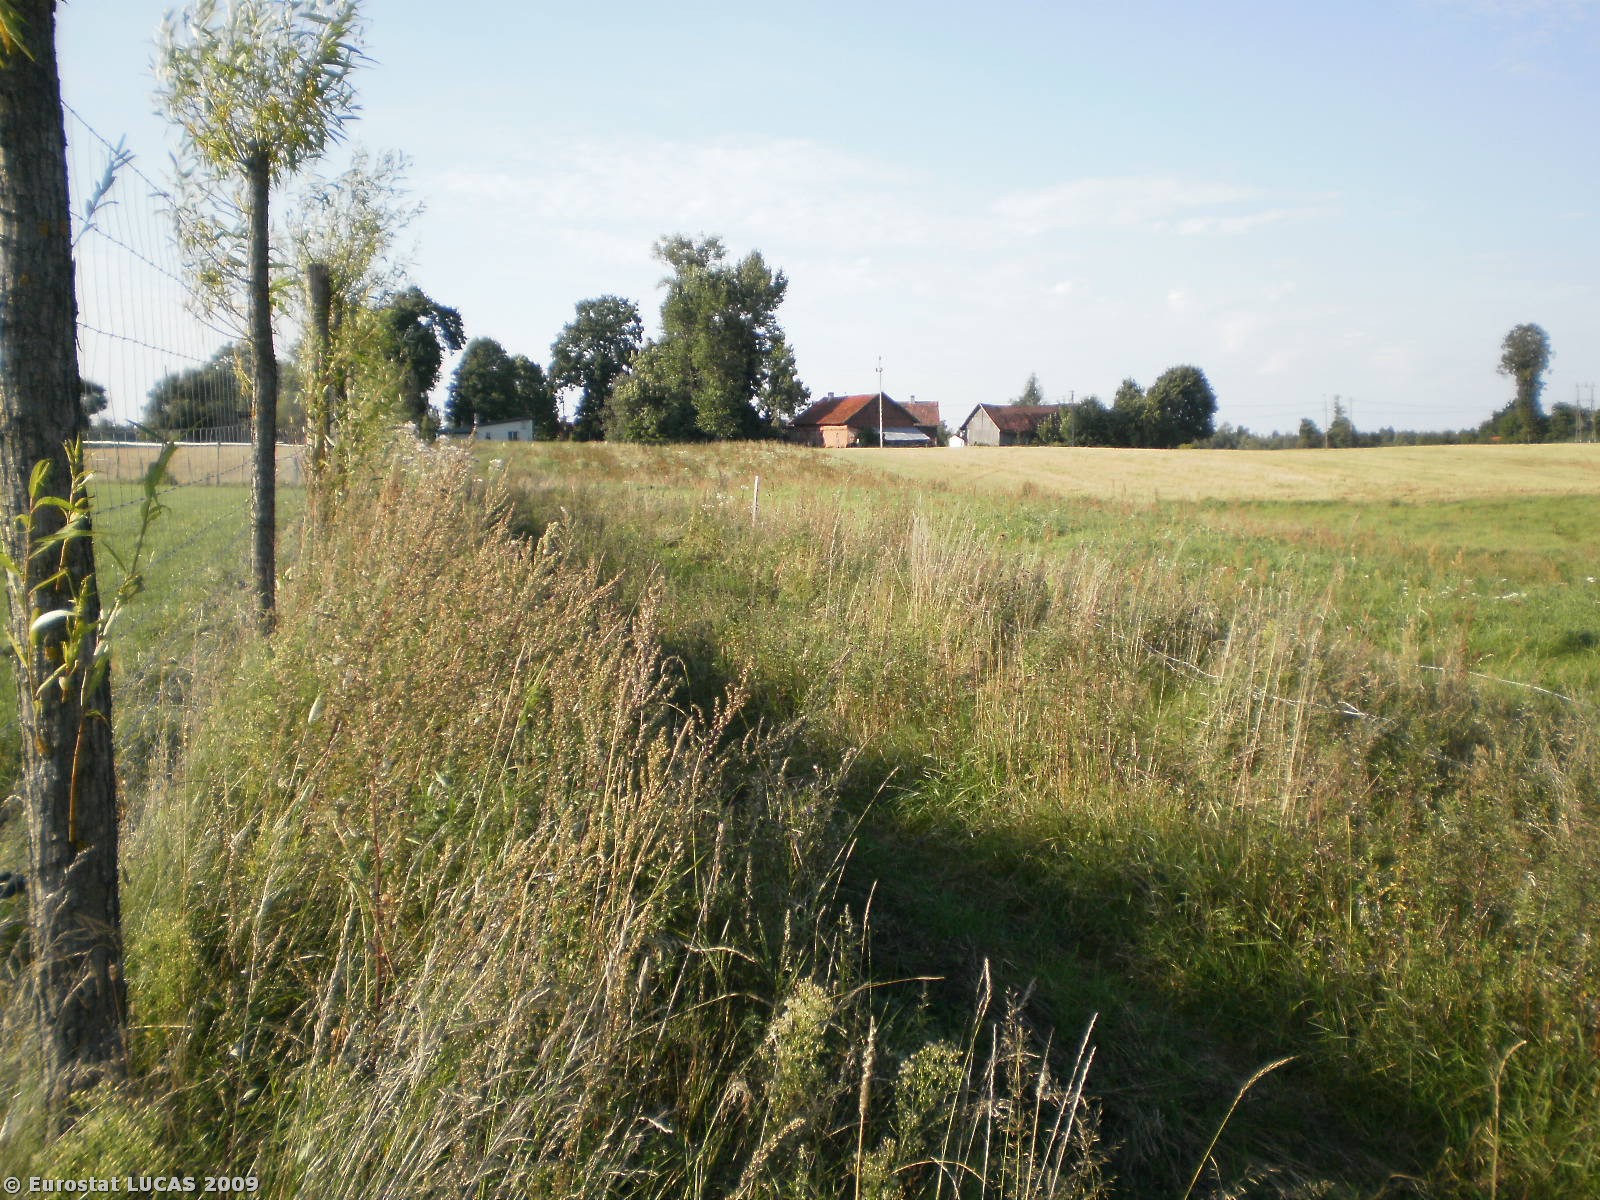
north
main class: Grassland
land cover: Grassland without tree/shrub cover
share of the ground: > 75 %
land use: Agriculture (excluding fallow land and kitchen gardens)
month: August
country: PL
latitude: 54.2913
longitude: 22.2118
